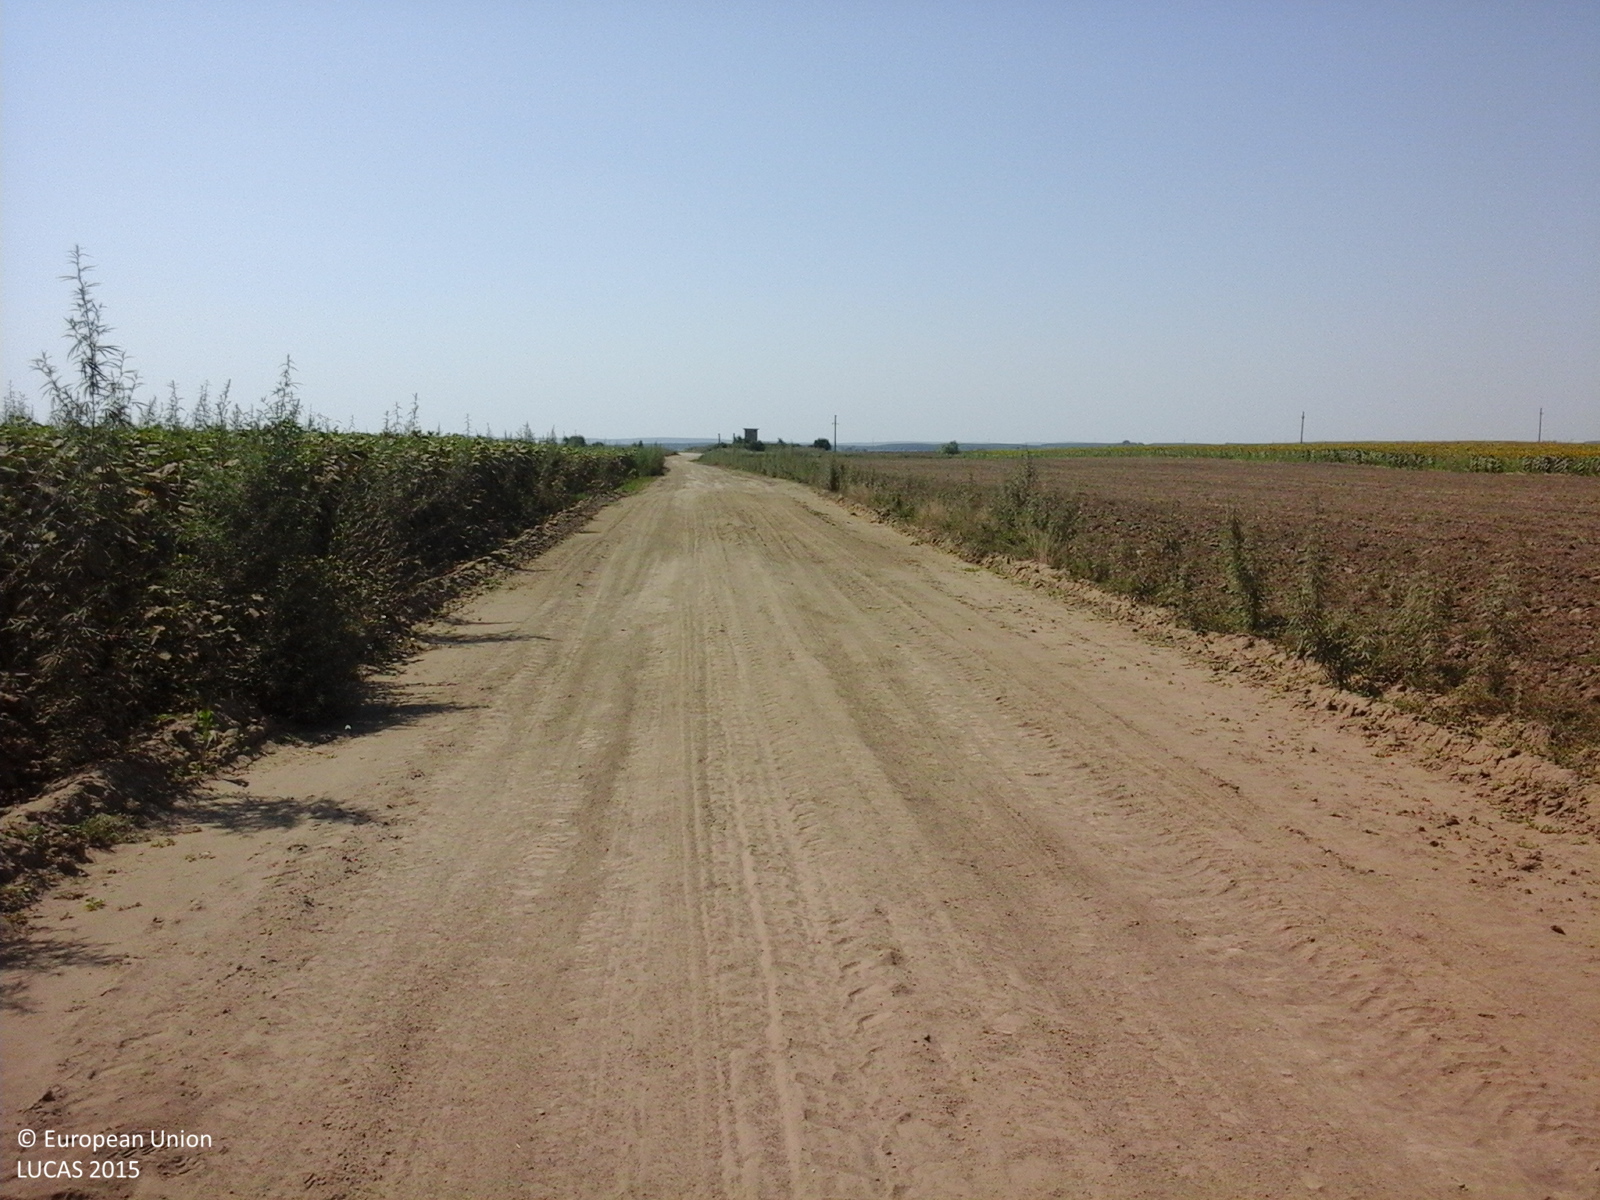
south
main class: Cropland
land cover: Sunflower
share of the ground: > 75 %
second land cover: Other fibre and oleaginous crops
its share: 50 - 75 %
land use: Agriculture (excluding fallow land and kitchen gardens)
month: July
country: RO
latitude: 44.2651
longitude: 27.5153
